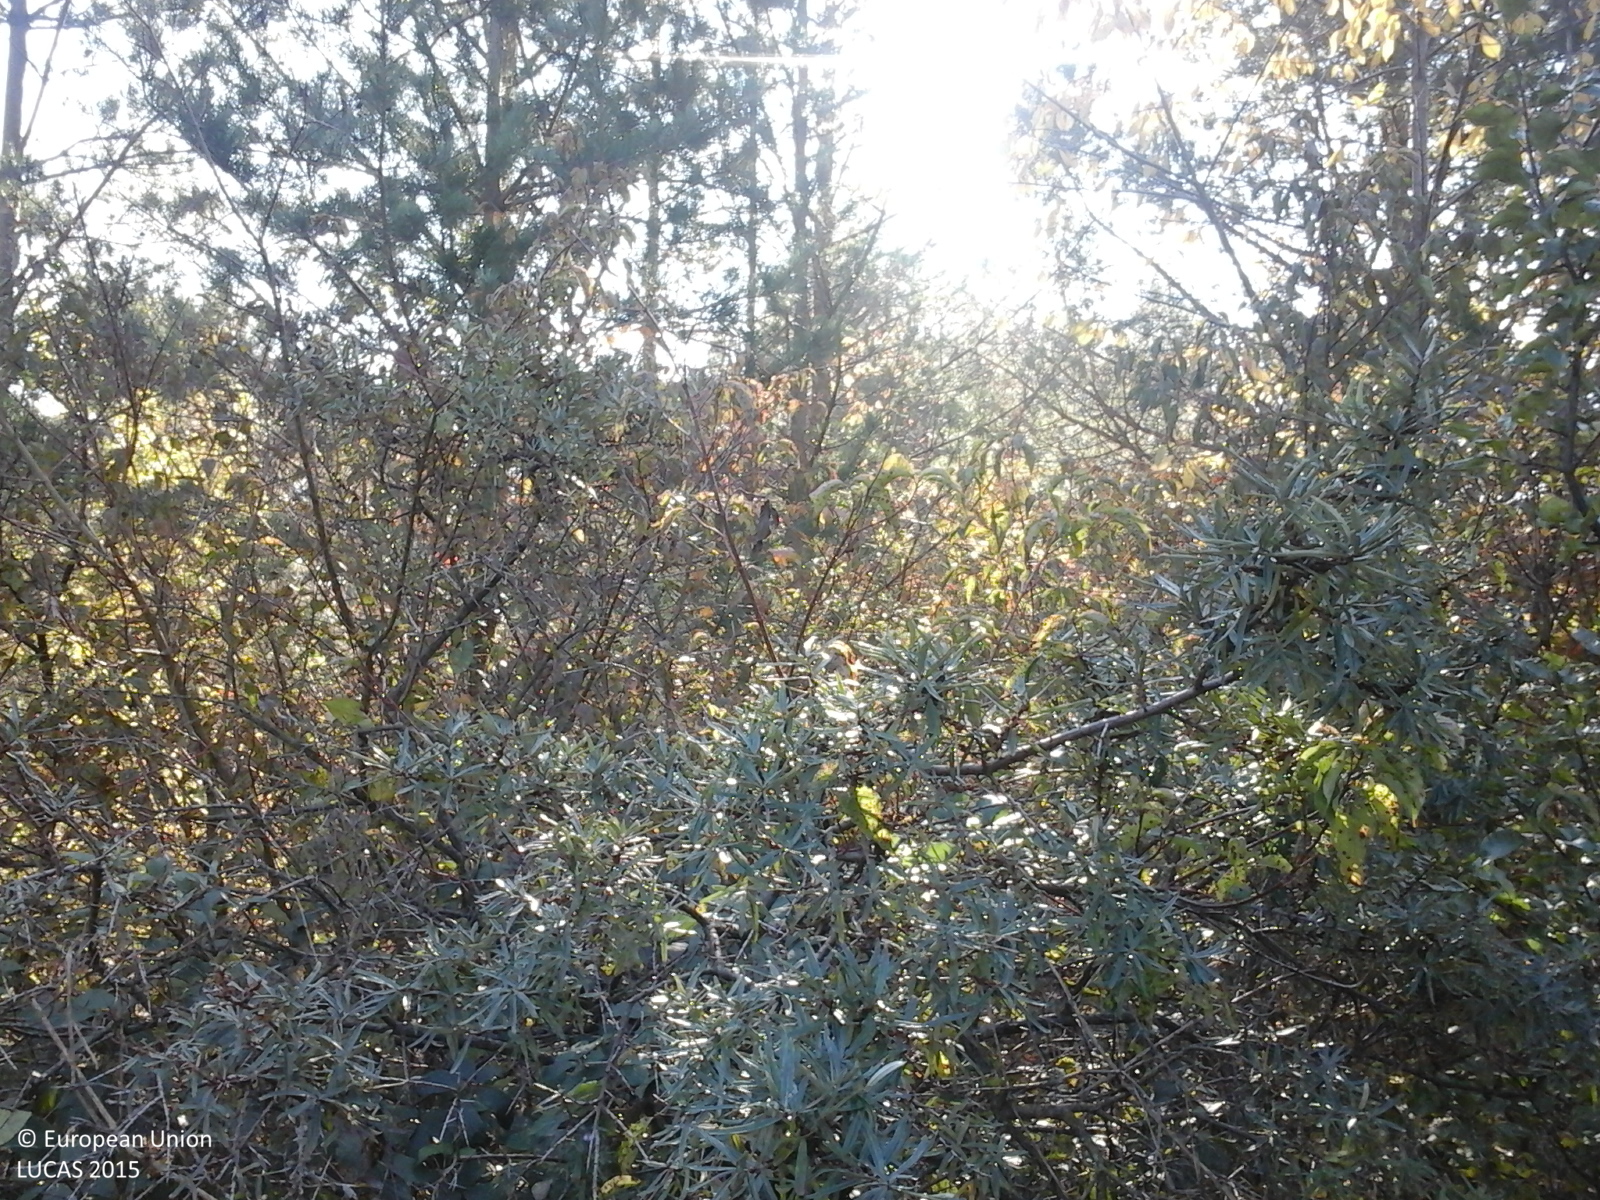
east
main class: Woodland
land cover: Pine dominated coniferous woodland
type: alpine coniferous forest
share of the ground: > 75 %
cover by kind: coniferous forest trees 100 %
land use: Forestry
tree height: > 5 m
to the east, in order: Pine dominated coniferous woodland
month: October
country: RO
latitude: 45.9866
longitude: 26.6713
